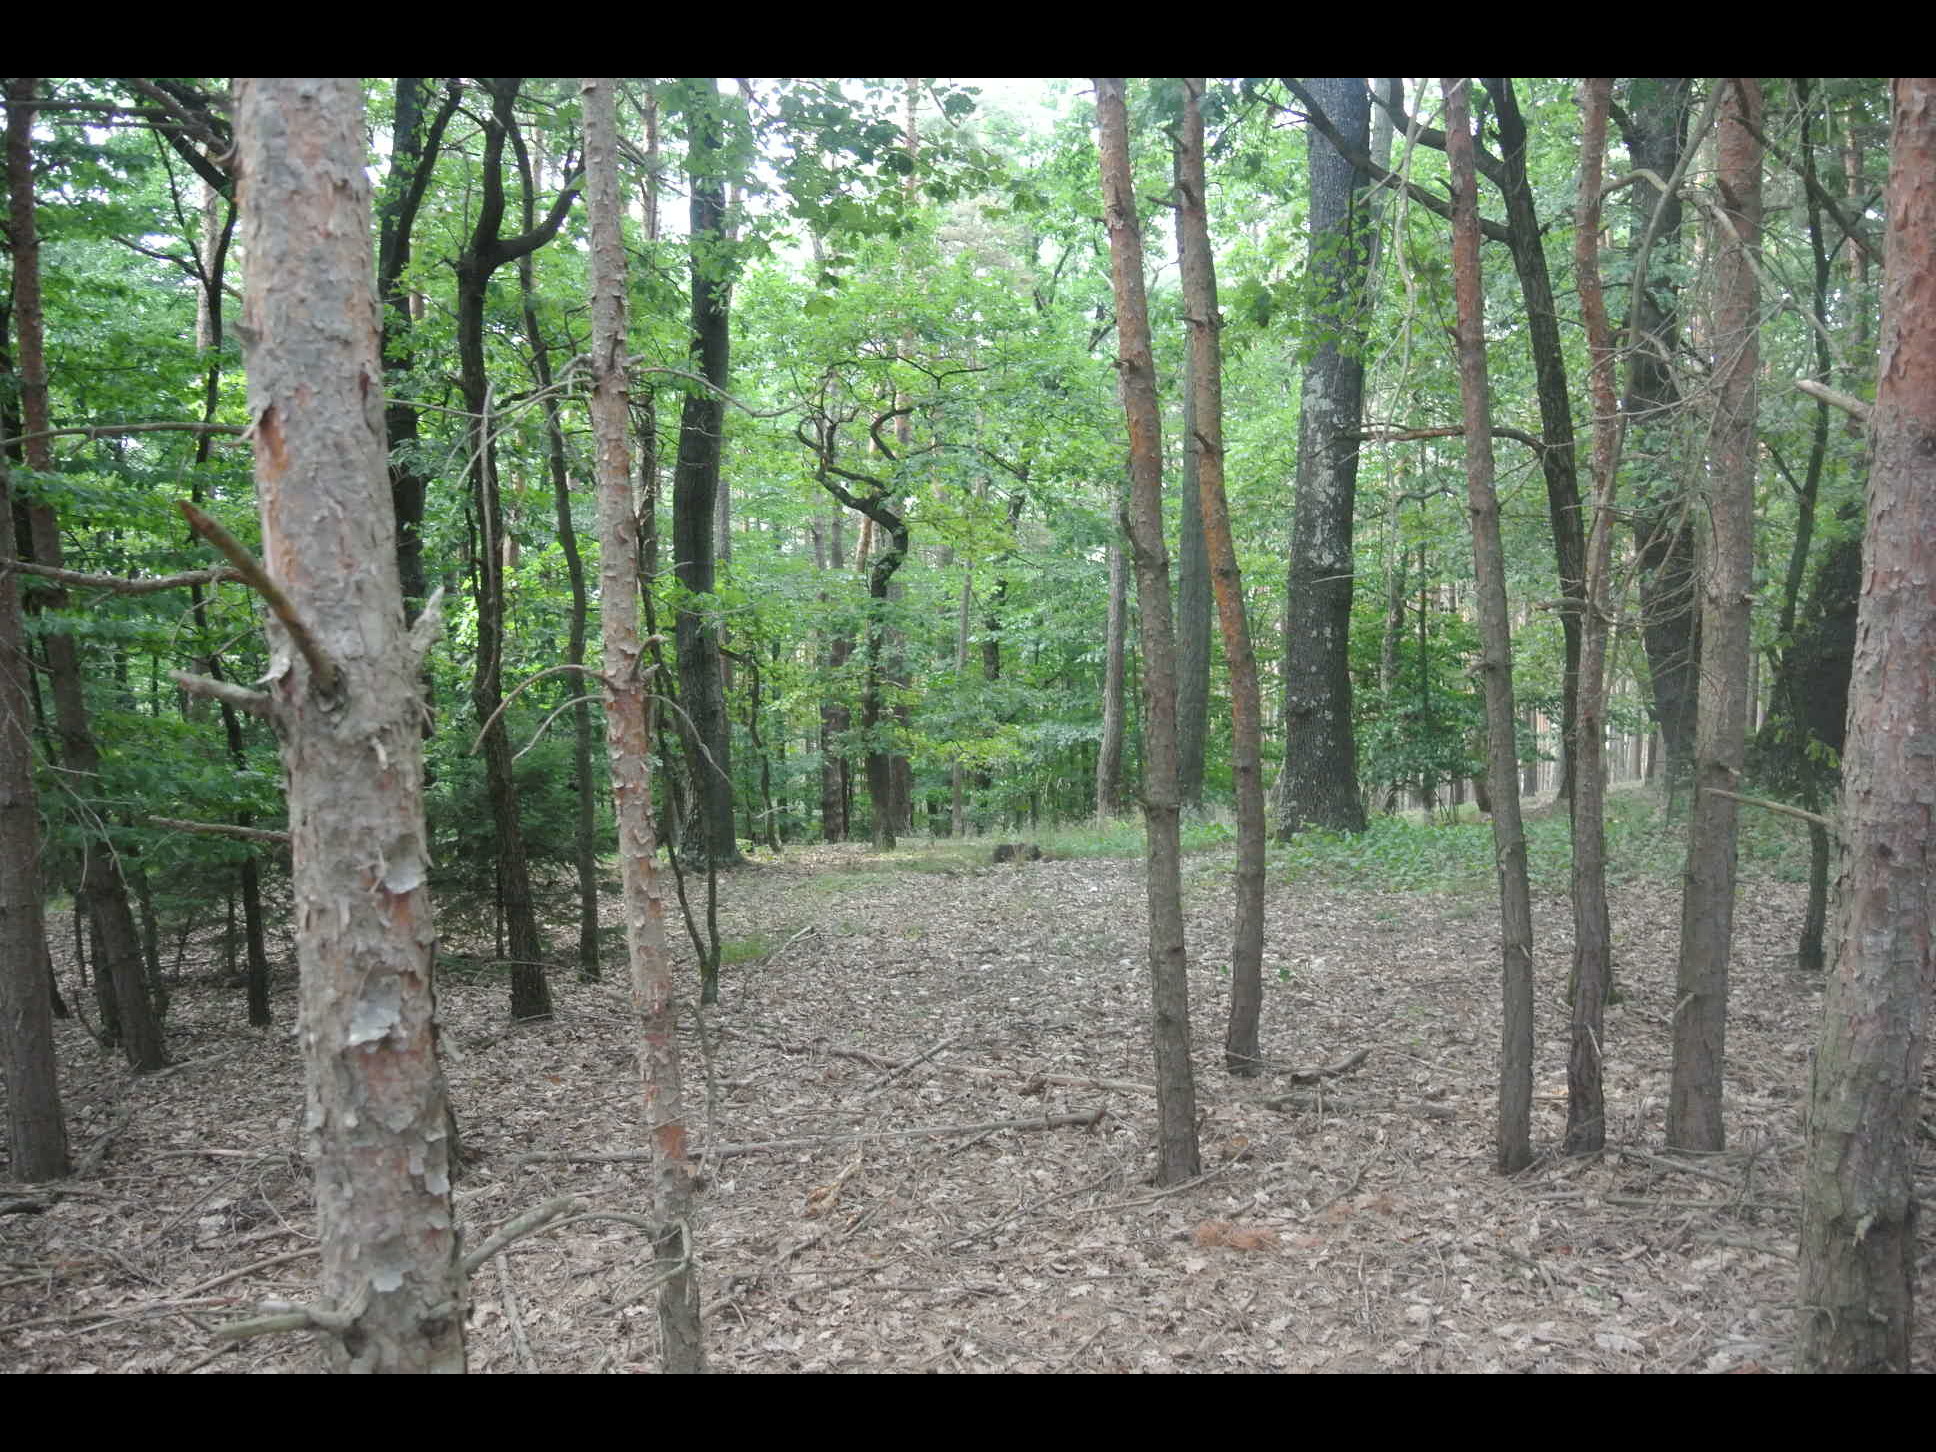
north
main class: Woodland
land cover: Pine dominated coniferous woodland
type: alpine coniferous forest
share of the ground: > 75 %
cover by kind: coniferous forest trees 90 %, unconsolidated bare surface 10 %
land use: Forestry
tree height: > 5 m
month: July
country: AT
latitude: 47.4429
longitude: 16.3817
